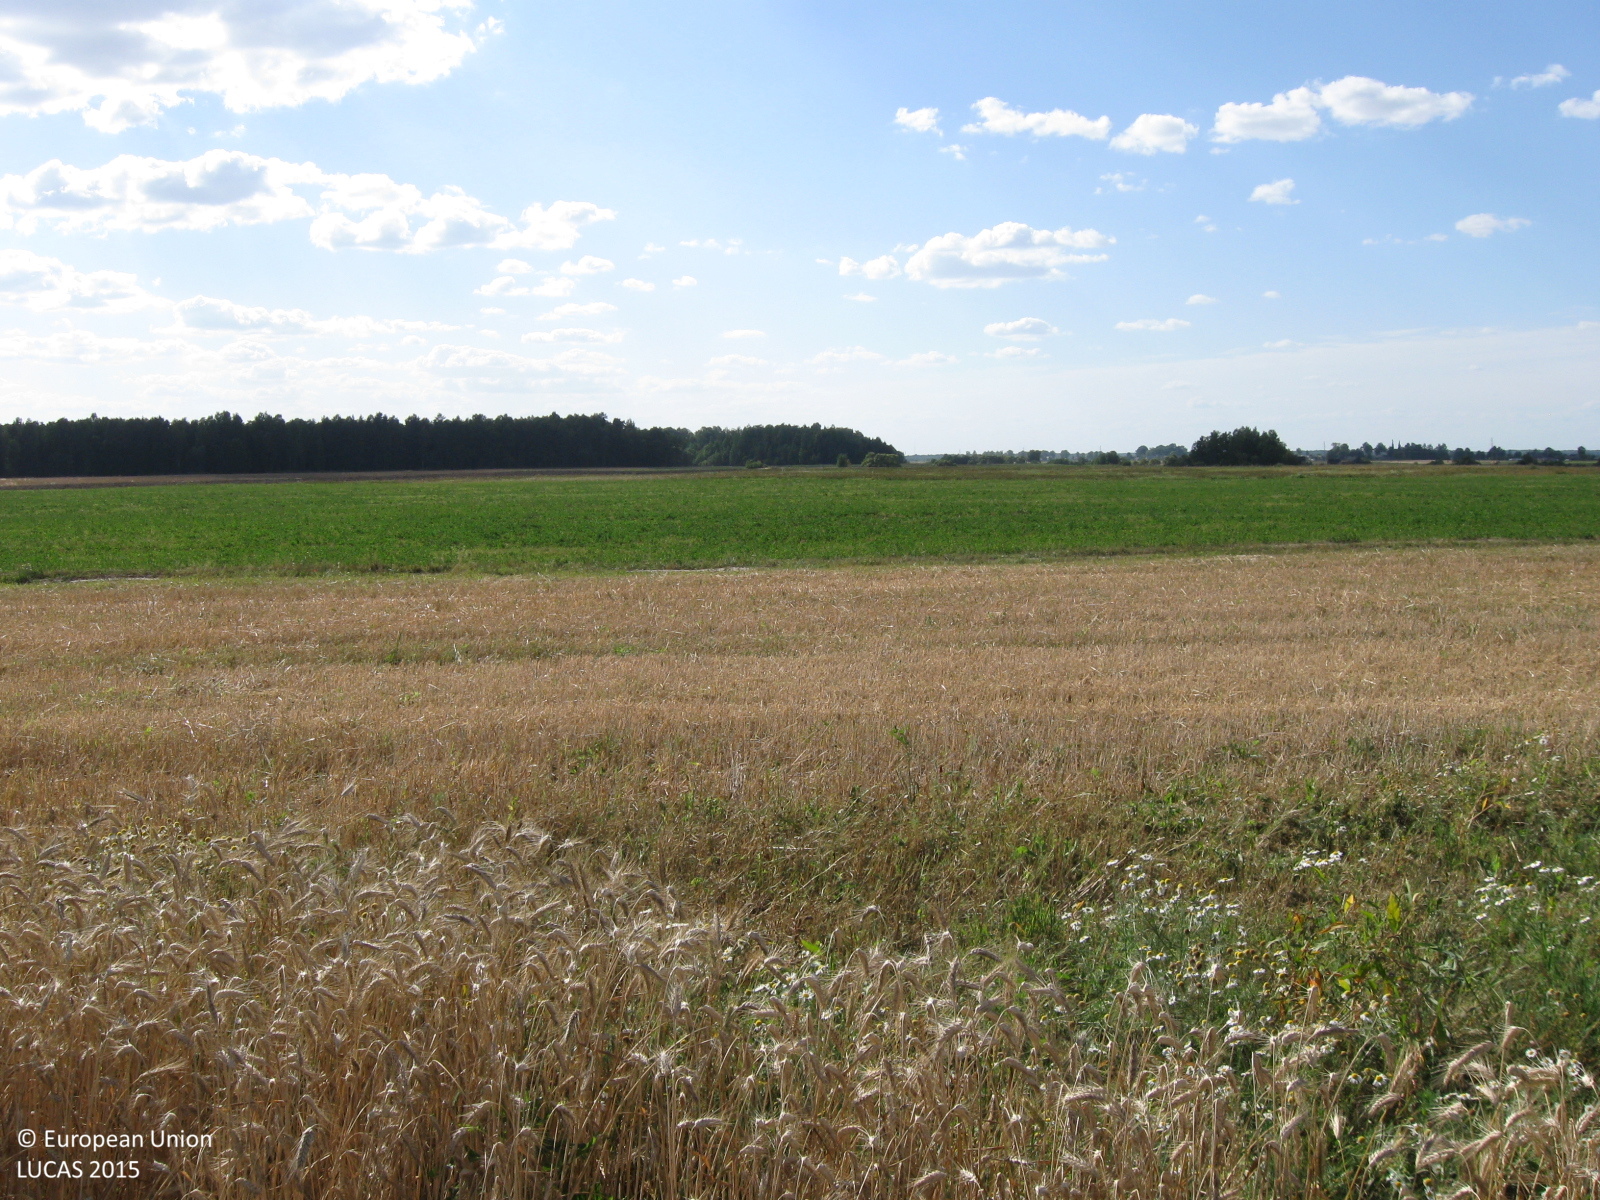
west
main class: Cropland
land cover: Triticale
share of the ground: > 75 %
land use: Agriculture (excluding fallow land and kitchen gardens)
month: August
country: LT
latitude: 55.2390
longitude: 22.5657
